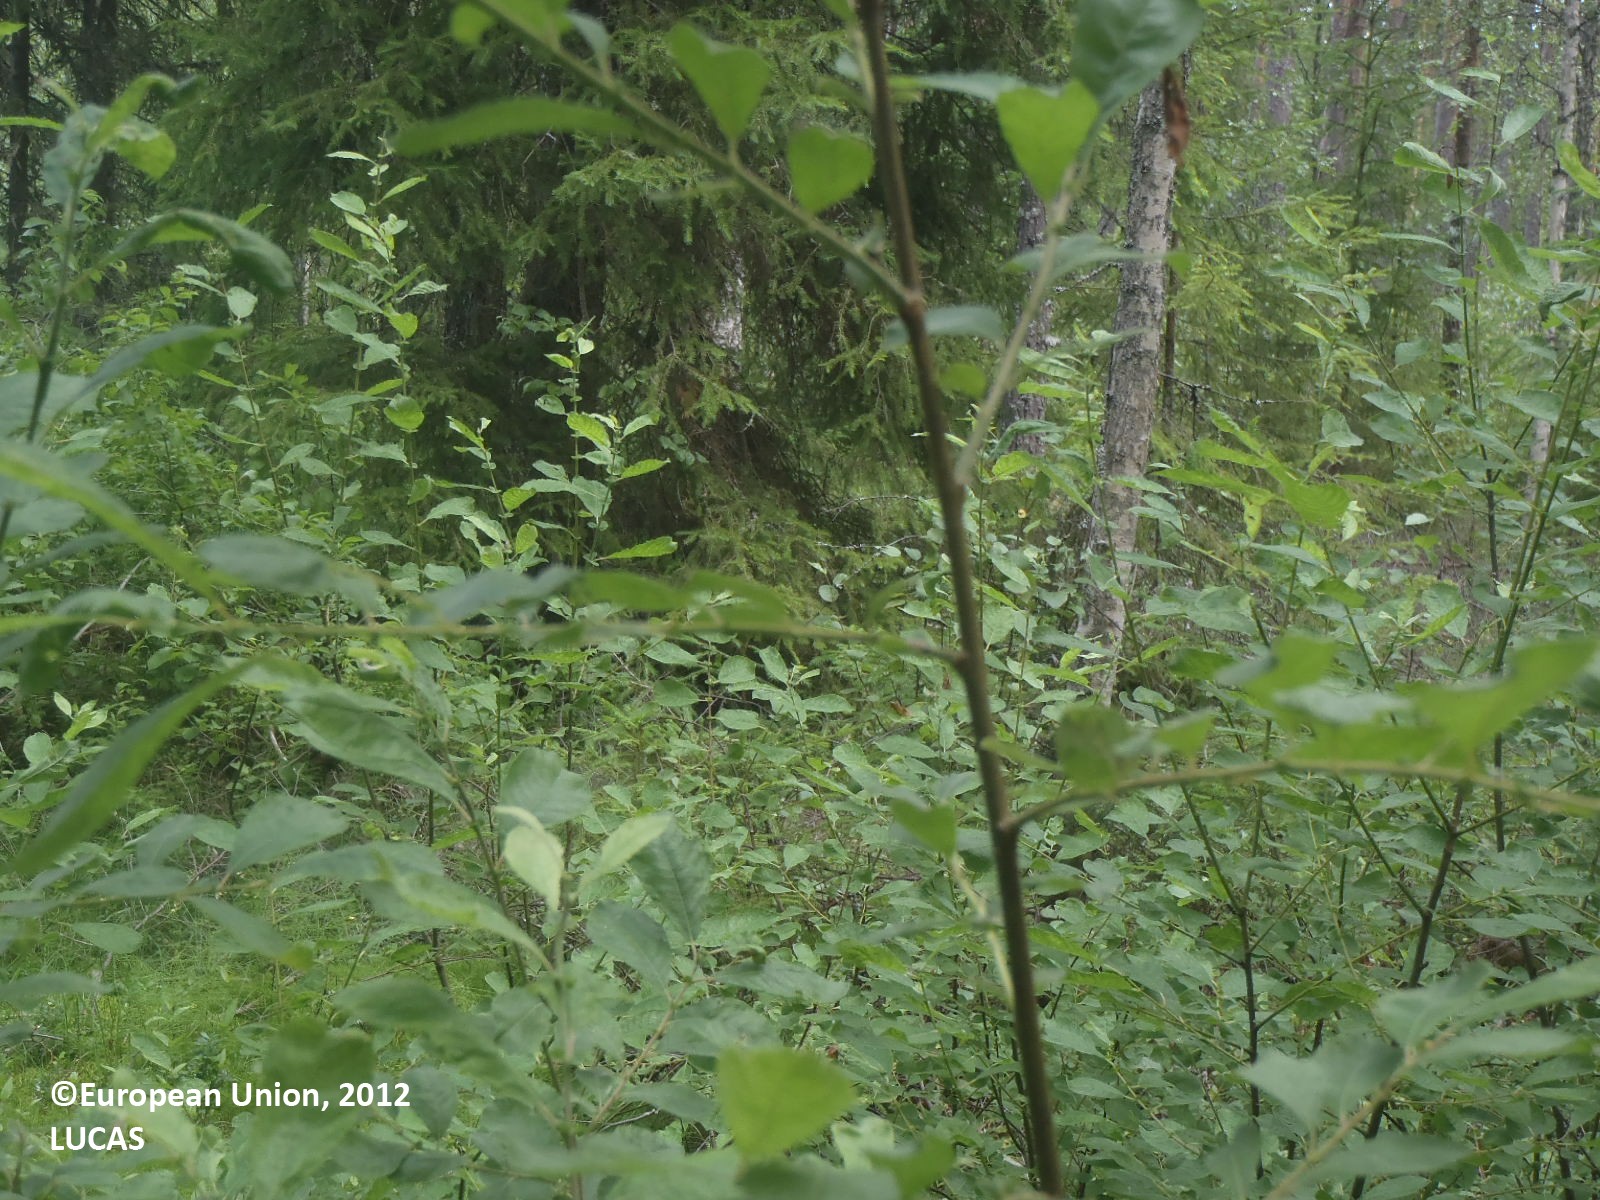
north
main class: Woodland
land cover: Spruce dominated mixed woodland
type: boreal forest
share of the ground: 50 - 75 %
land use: Forestry
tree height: > 5 m
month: July
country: FI
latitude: 60.9760
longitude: 21.8276
